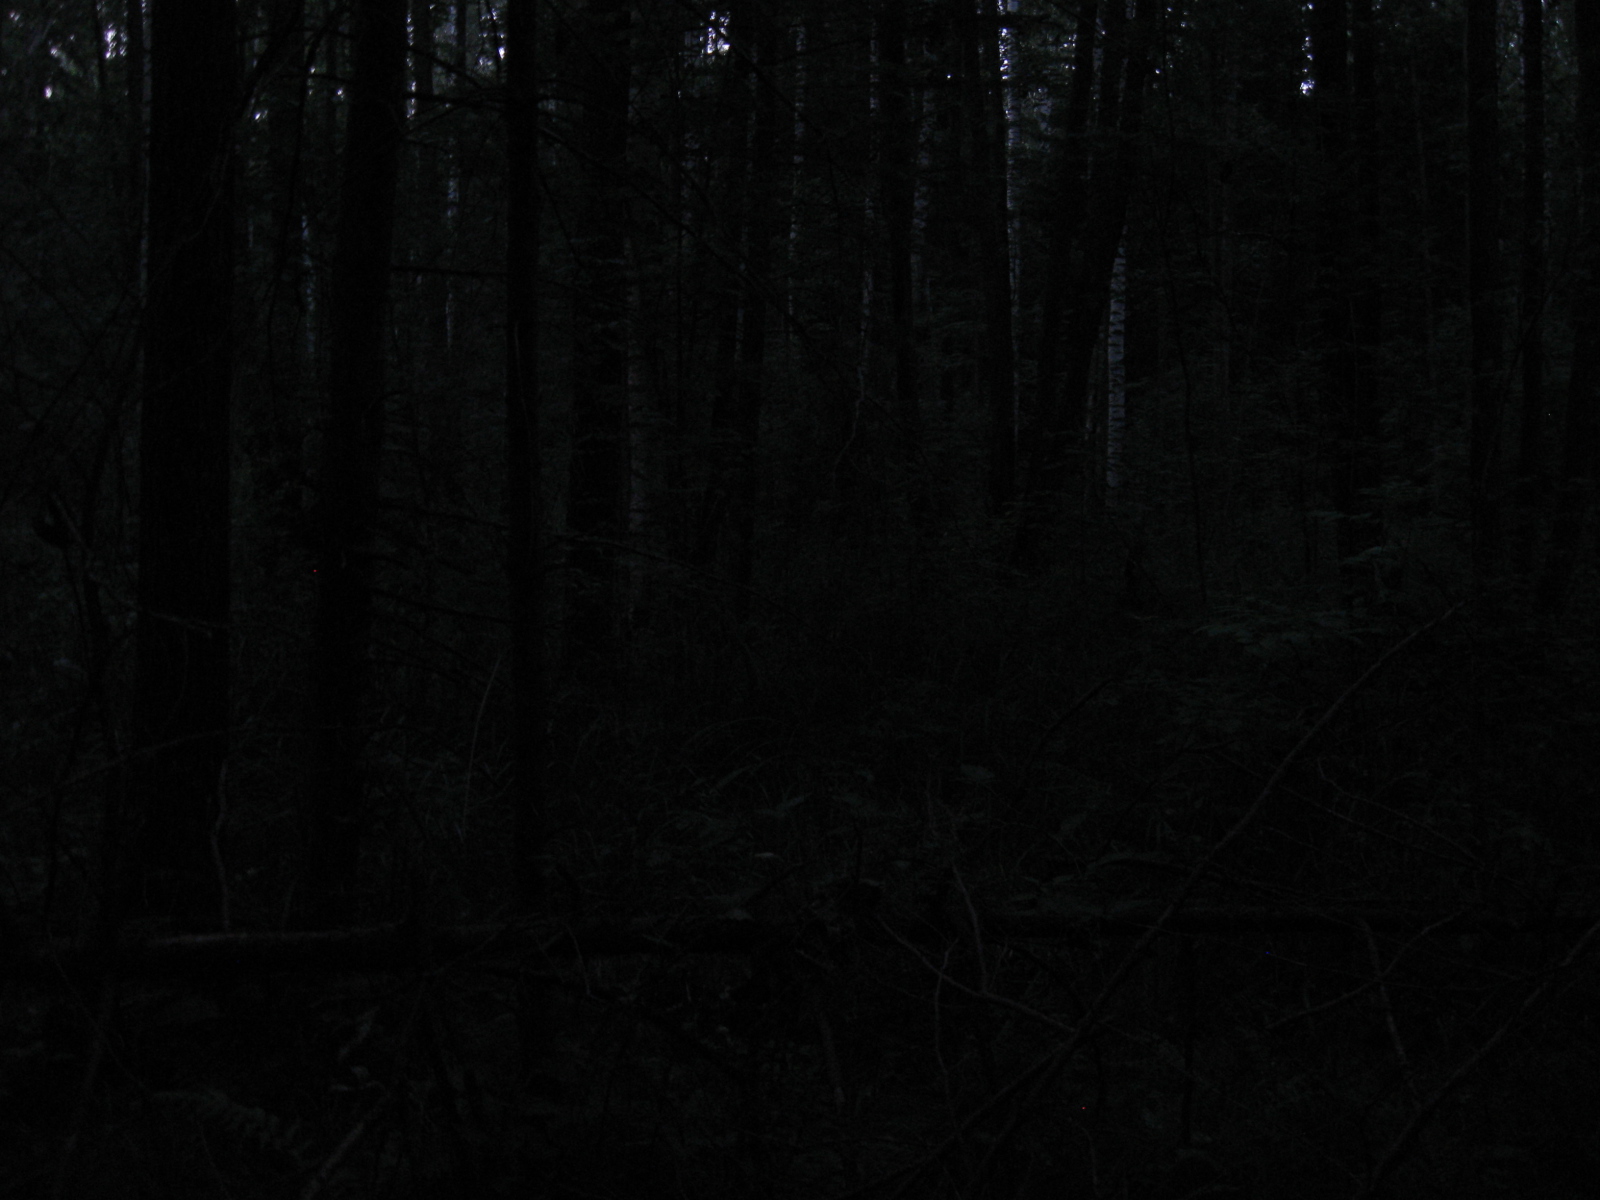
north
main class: Woodland
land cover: Other mixed woodland
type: hemiboreal forest and nemoral coniferous forest and mixed broadleaved-coniferous forest
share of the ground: > 75 %
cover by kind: broadleaved forest trees 65 %, coniferous forest trees 30 %, herbaceous plants 5 %
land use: Forestry
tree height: > 5 m
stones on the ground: < 10 %
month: August
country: LT
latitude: 54.6312
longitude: 23.3231
